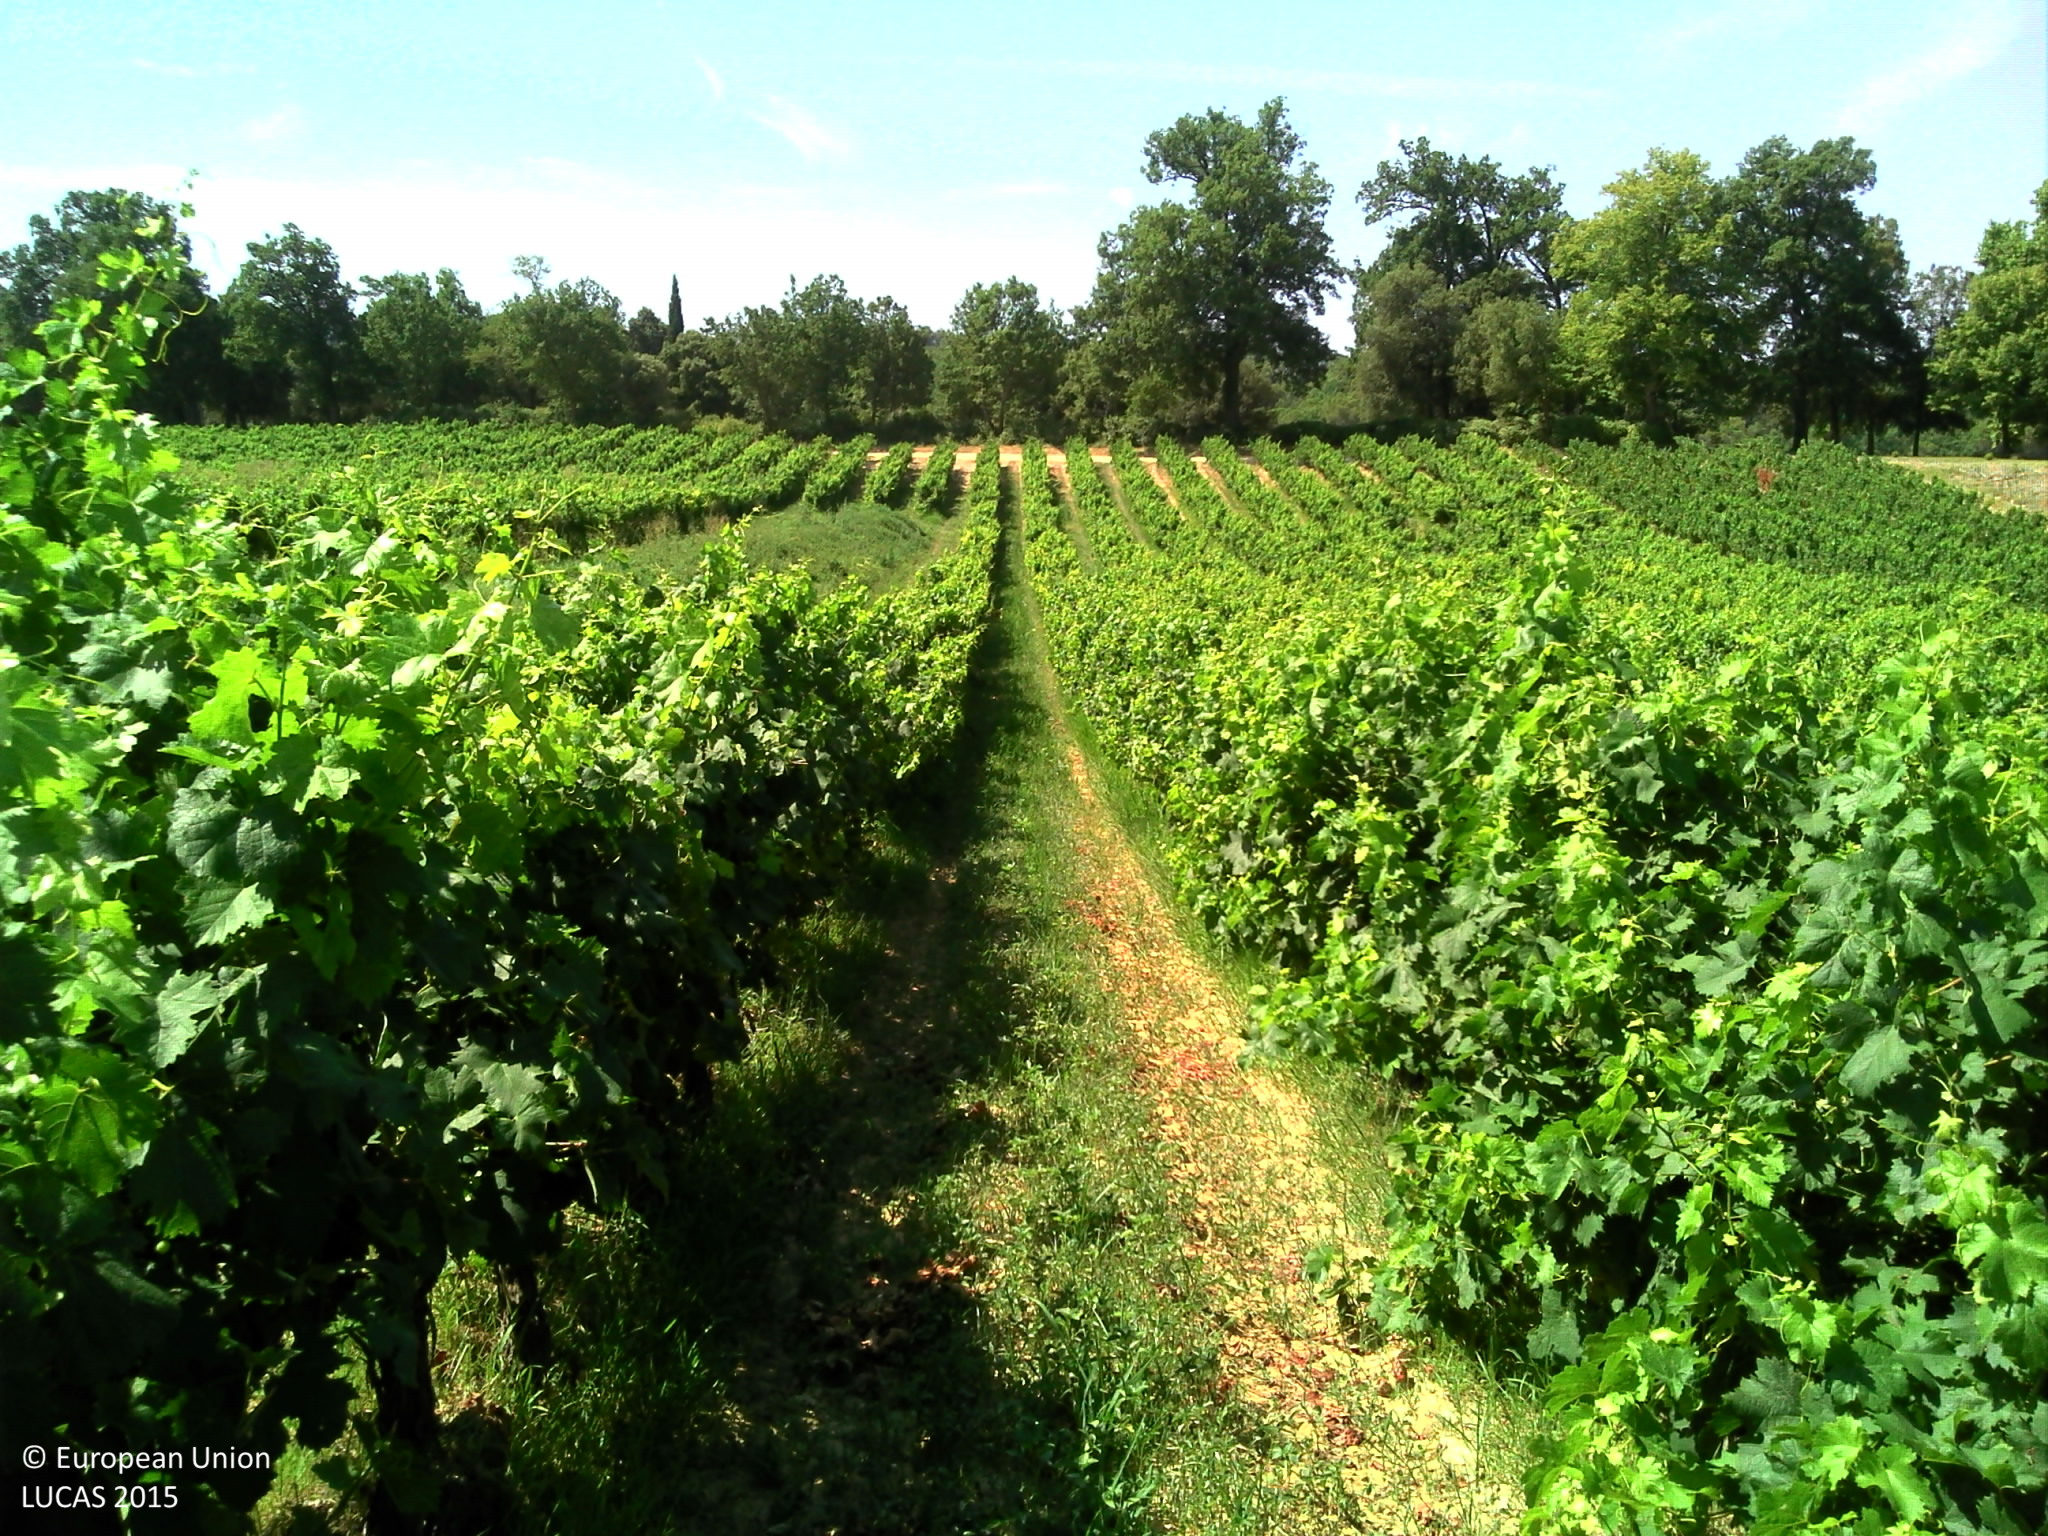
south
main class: Cropland
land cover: Vineyards
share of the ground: 25 - 50 %
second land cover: Grassland without tree/shrub cover
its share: 50 - 75 %
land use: Agriculture (excluding fallow land and kitchen gardens)
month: July
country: FR
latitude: 43.7144
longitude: 5.5781
